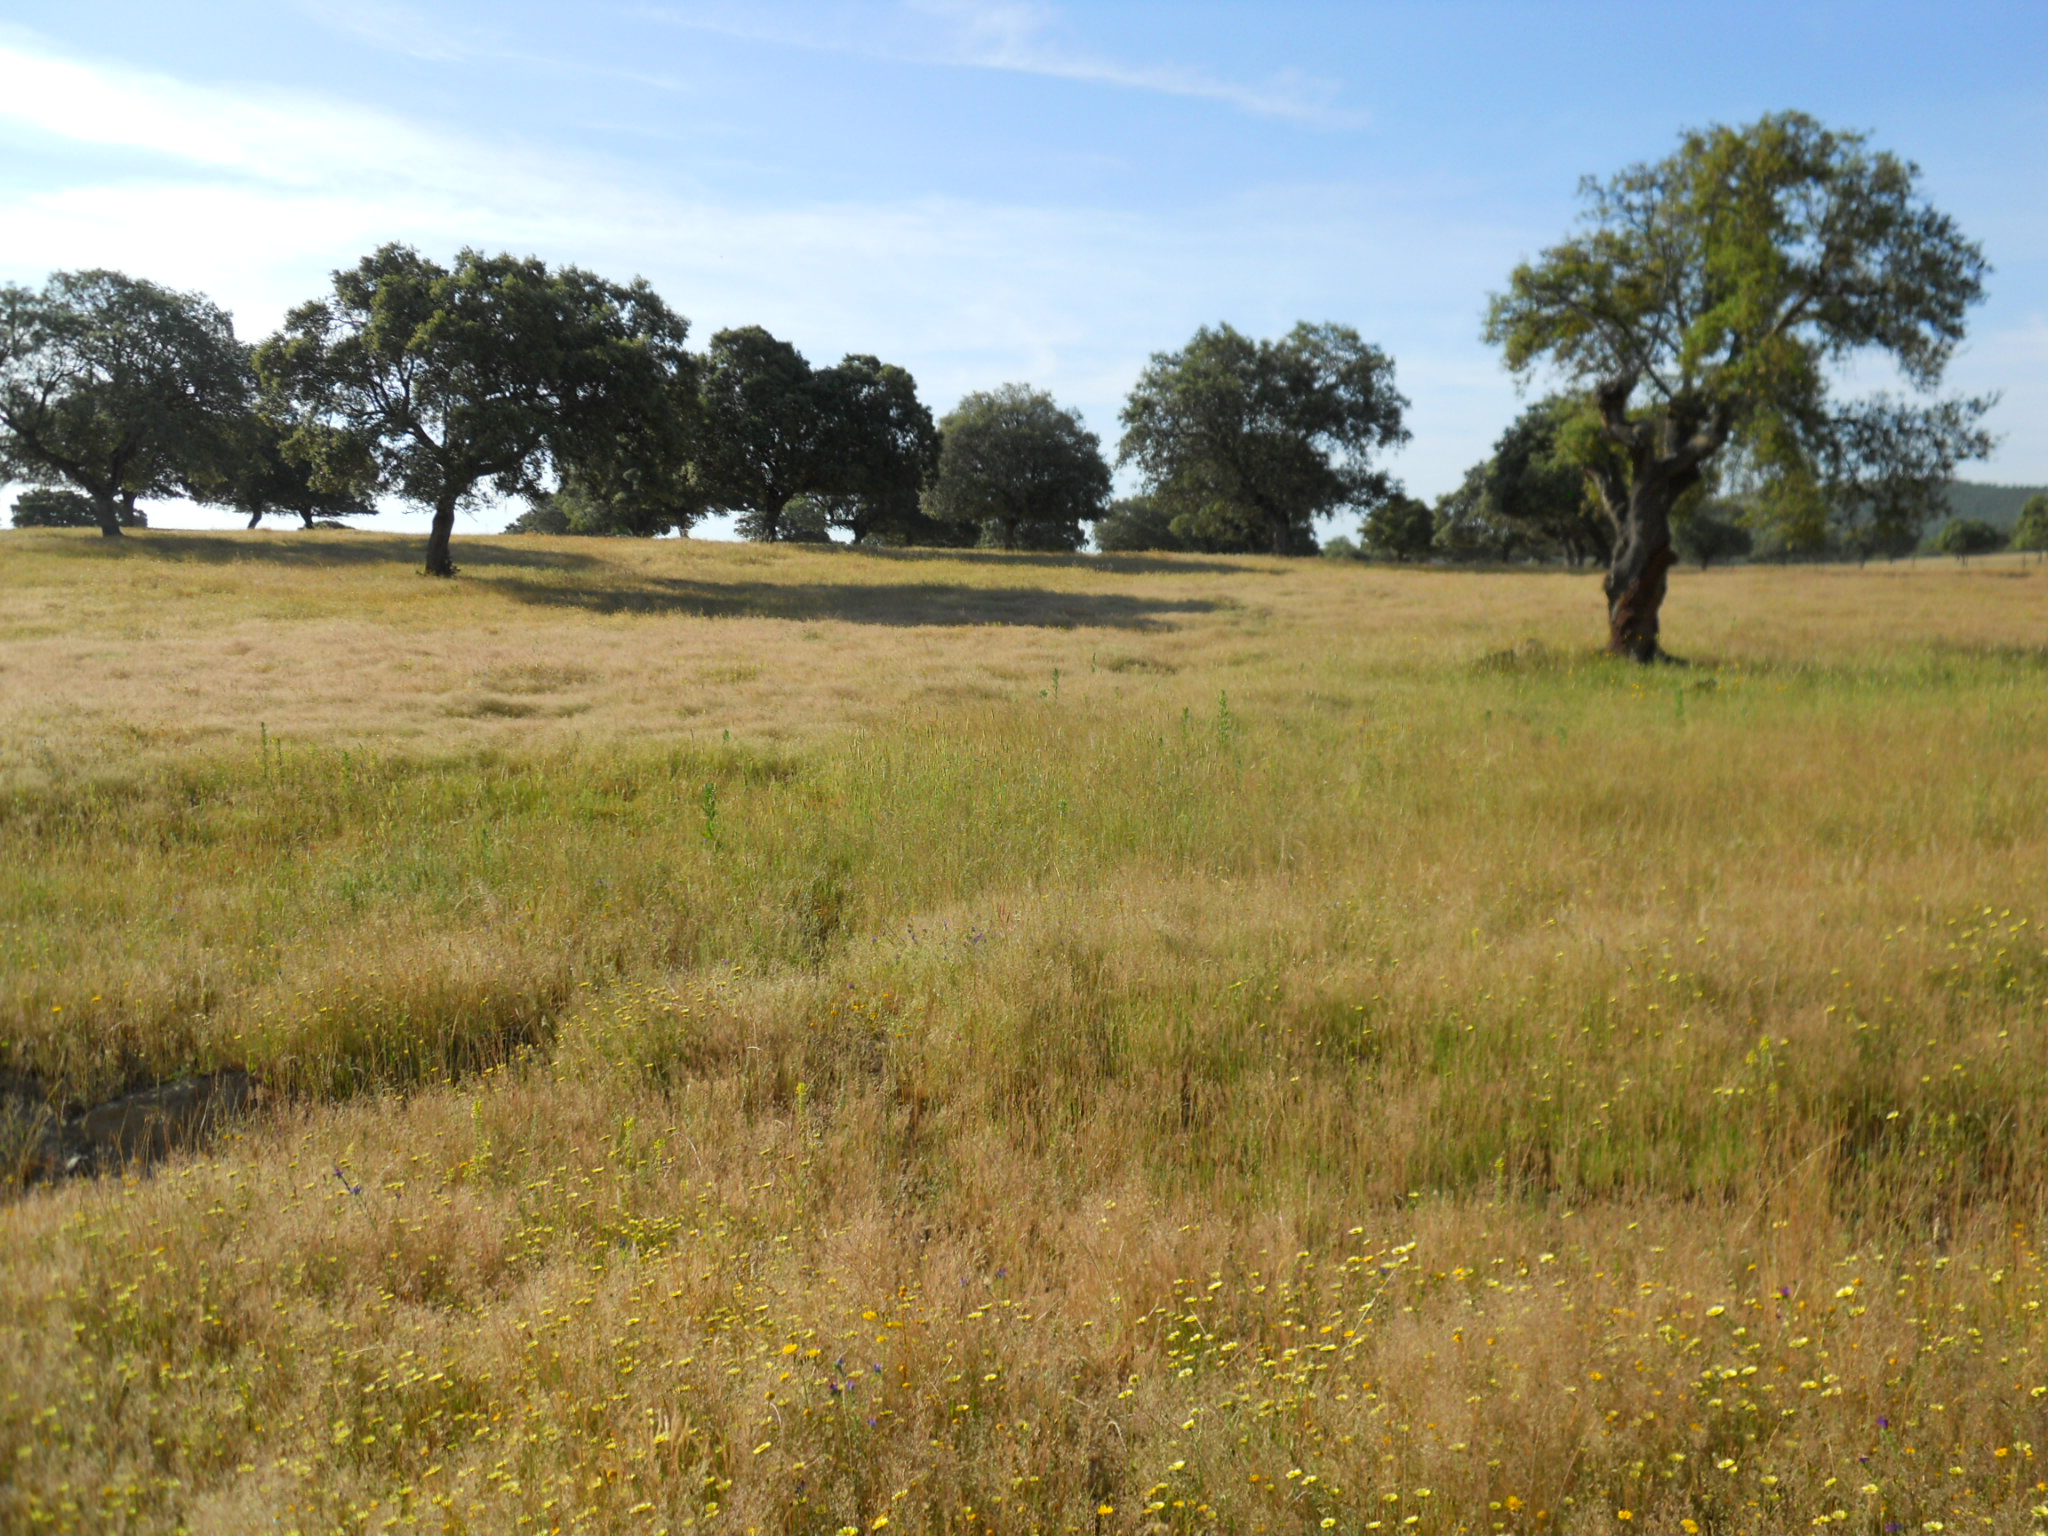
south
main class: Woodland
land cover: Broadleaved woodland
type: broadleaved evergreen forest
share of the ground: > 75 %
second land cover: Grassland without tree/shrub cover
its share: 50 - 75 %
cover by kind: broadleaved forest trees 90 %, herbaceous plants 10 %
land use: Forestry
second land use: Agriculture (excluding fallow land and kitchen gardens)
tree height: > 5 m
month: May
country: ES
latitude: 39.2467
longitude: -6.3905
